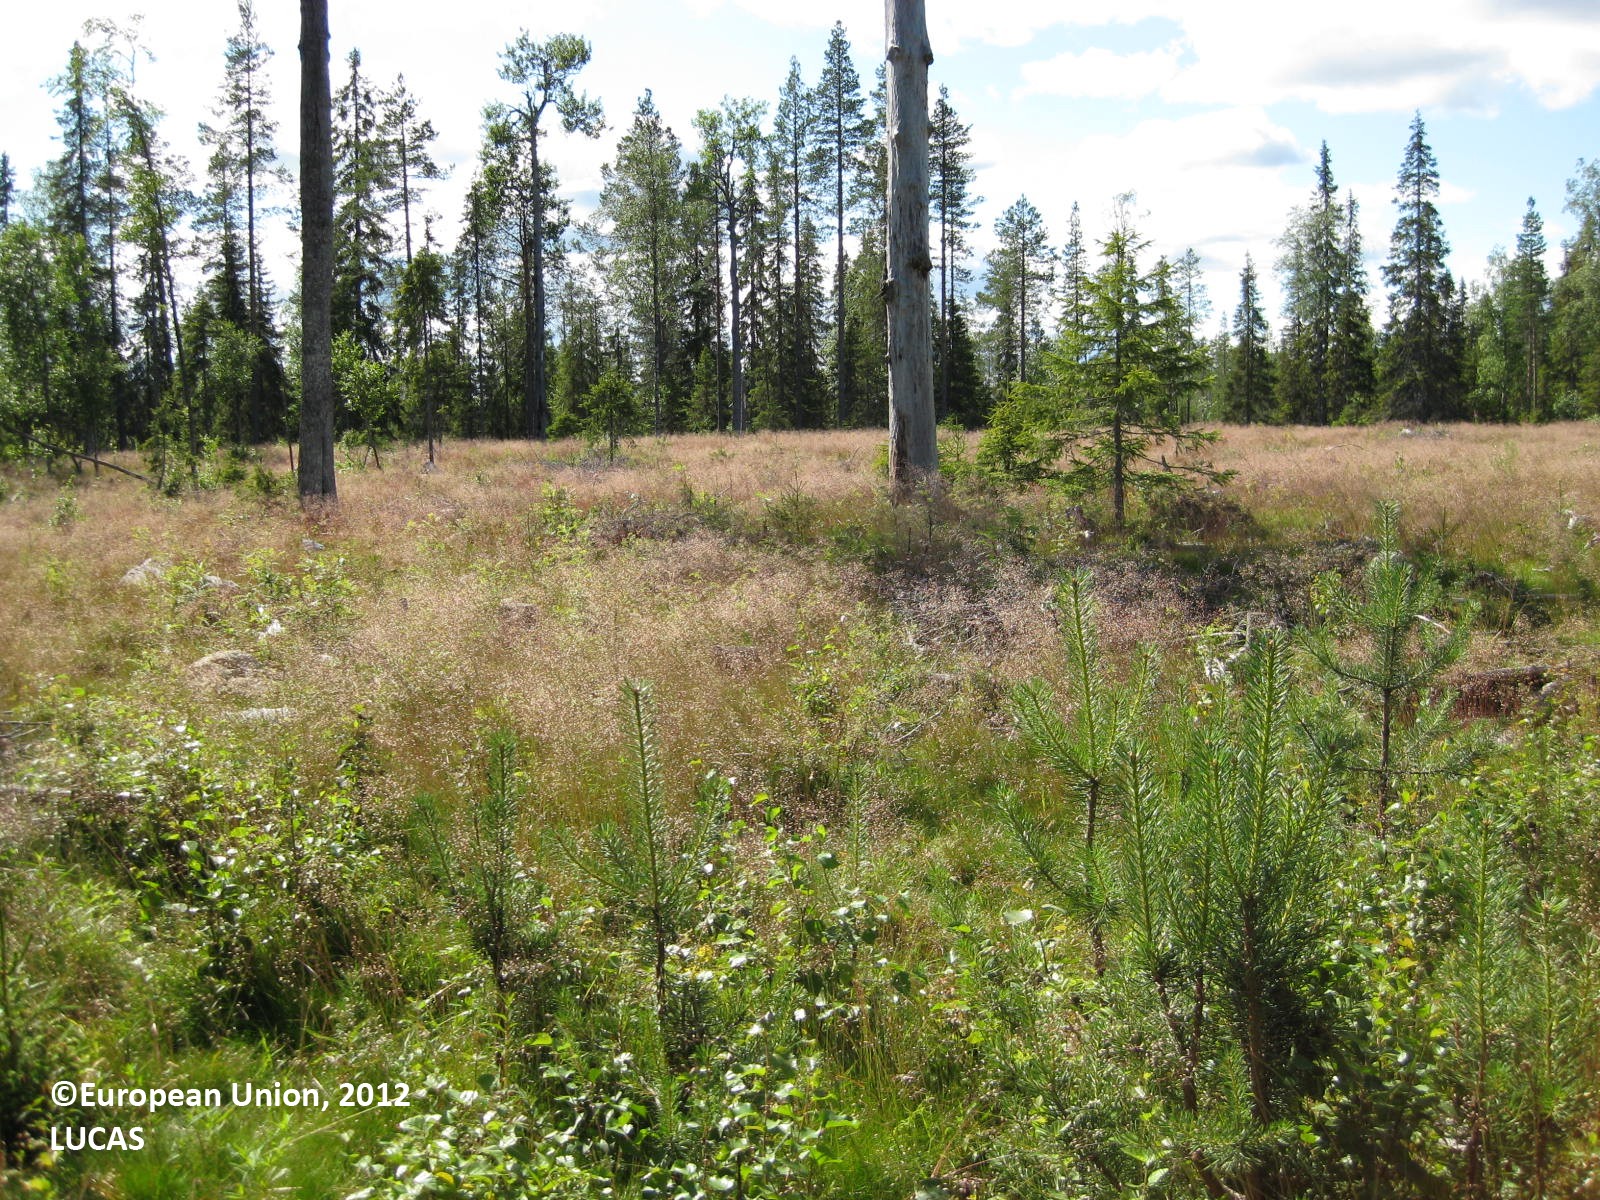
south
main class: Grassland
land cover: Grassland with sparse tree/shrub cover
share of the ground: > 75 %
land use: Forestry
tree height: < 5 m
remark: Clear cut
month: July
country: FI
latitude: 65.6830
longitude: 28.3705
